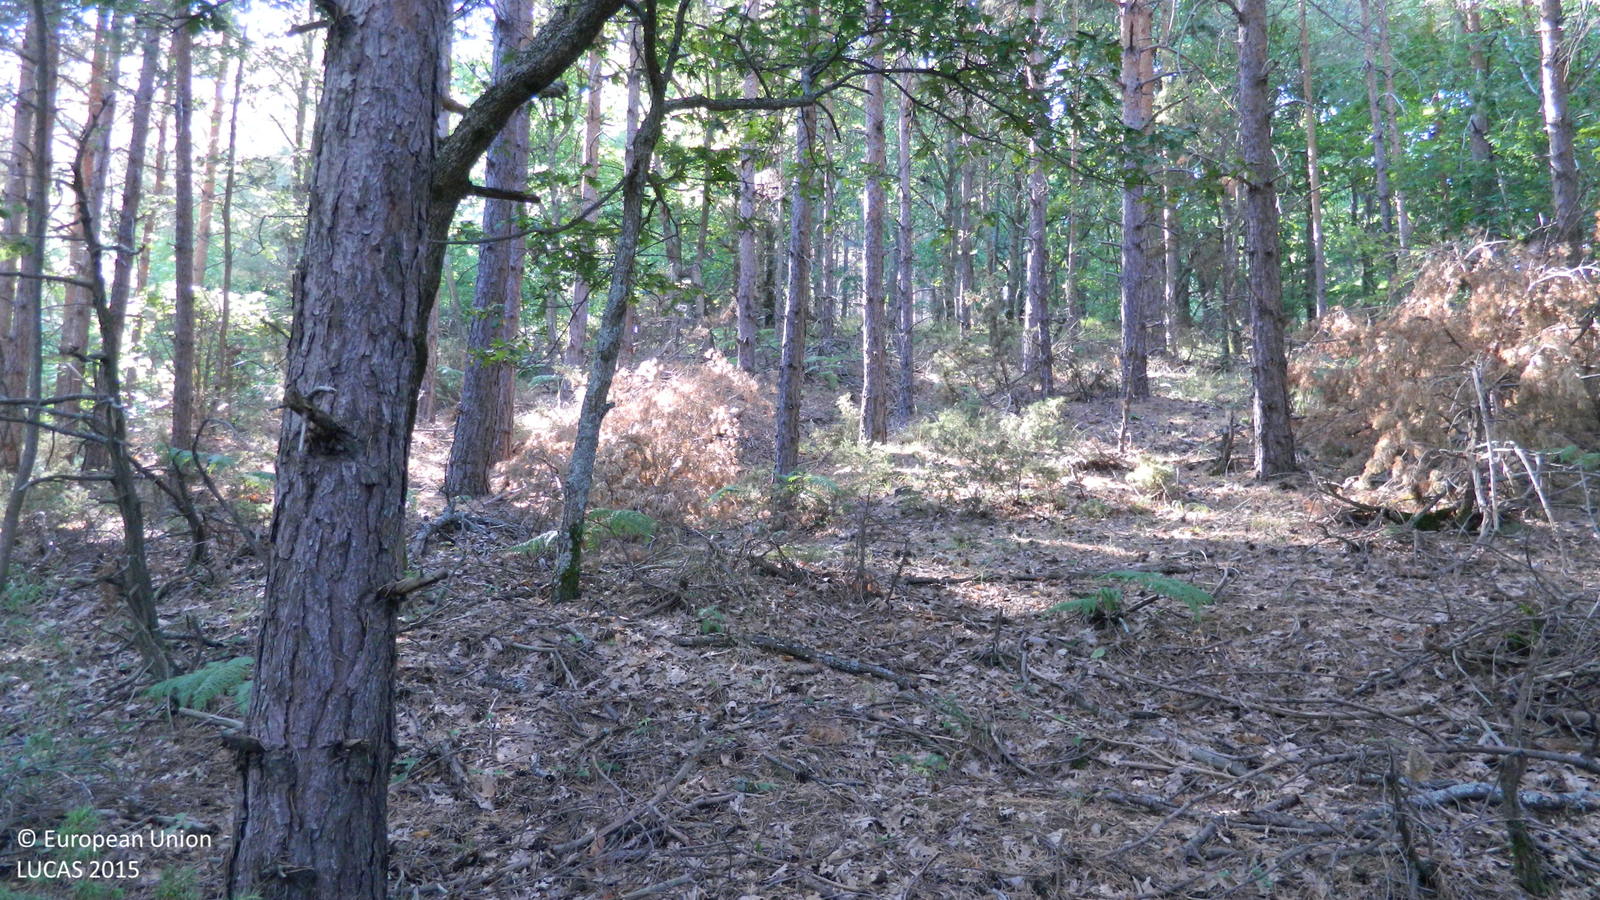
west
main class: Woodland
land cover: Pine dominated mixed woodland
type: hemiboreal forest and nemoral coniferous forest and mixed broadleaved-coniferous forest
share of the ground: > 75 %
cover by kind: coniferous forest trees 75 %, broadleaved forest trees 25 %
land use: Forestry
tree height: > 5 m
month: August
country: BG
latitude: 41.5571
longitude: 25.8808
